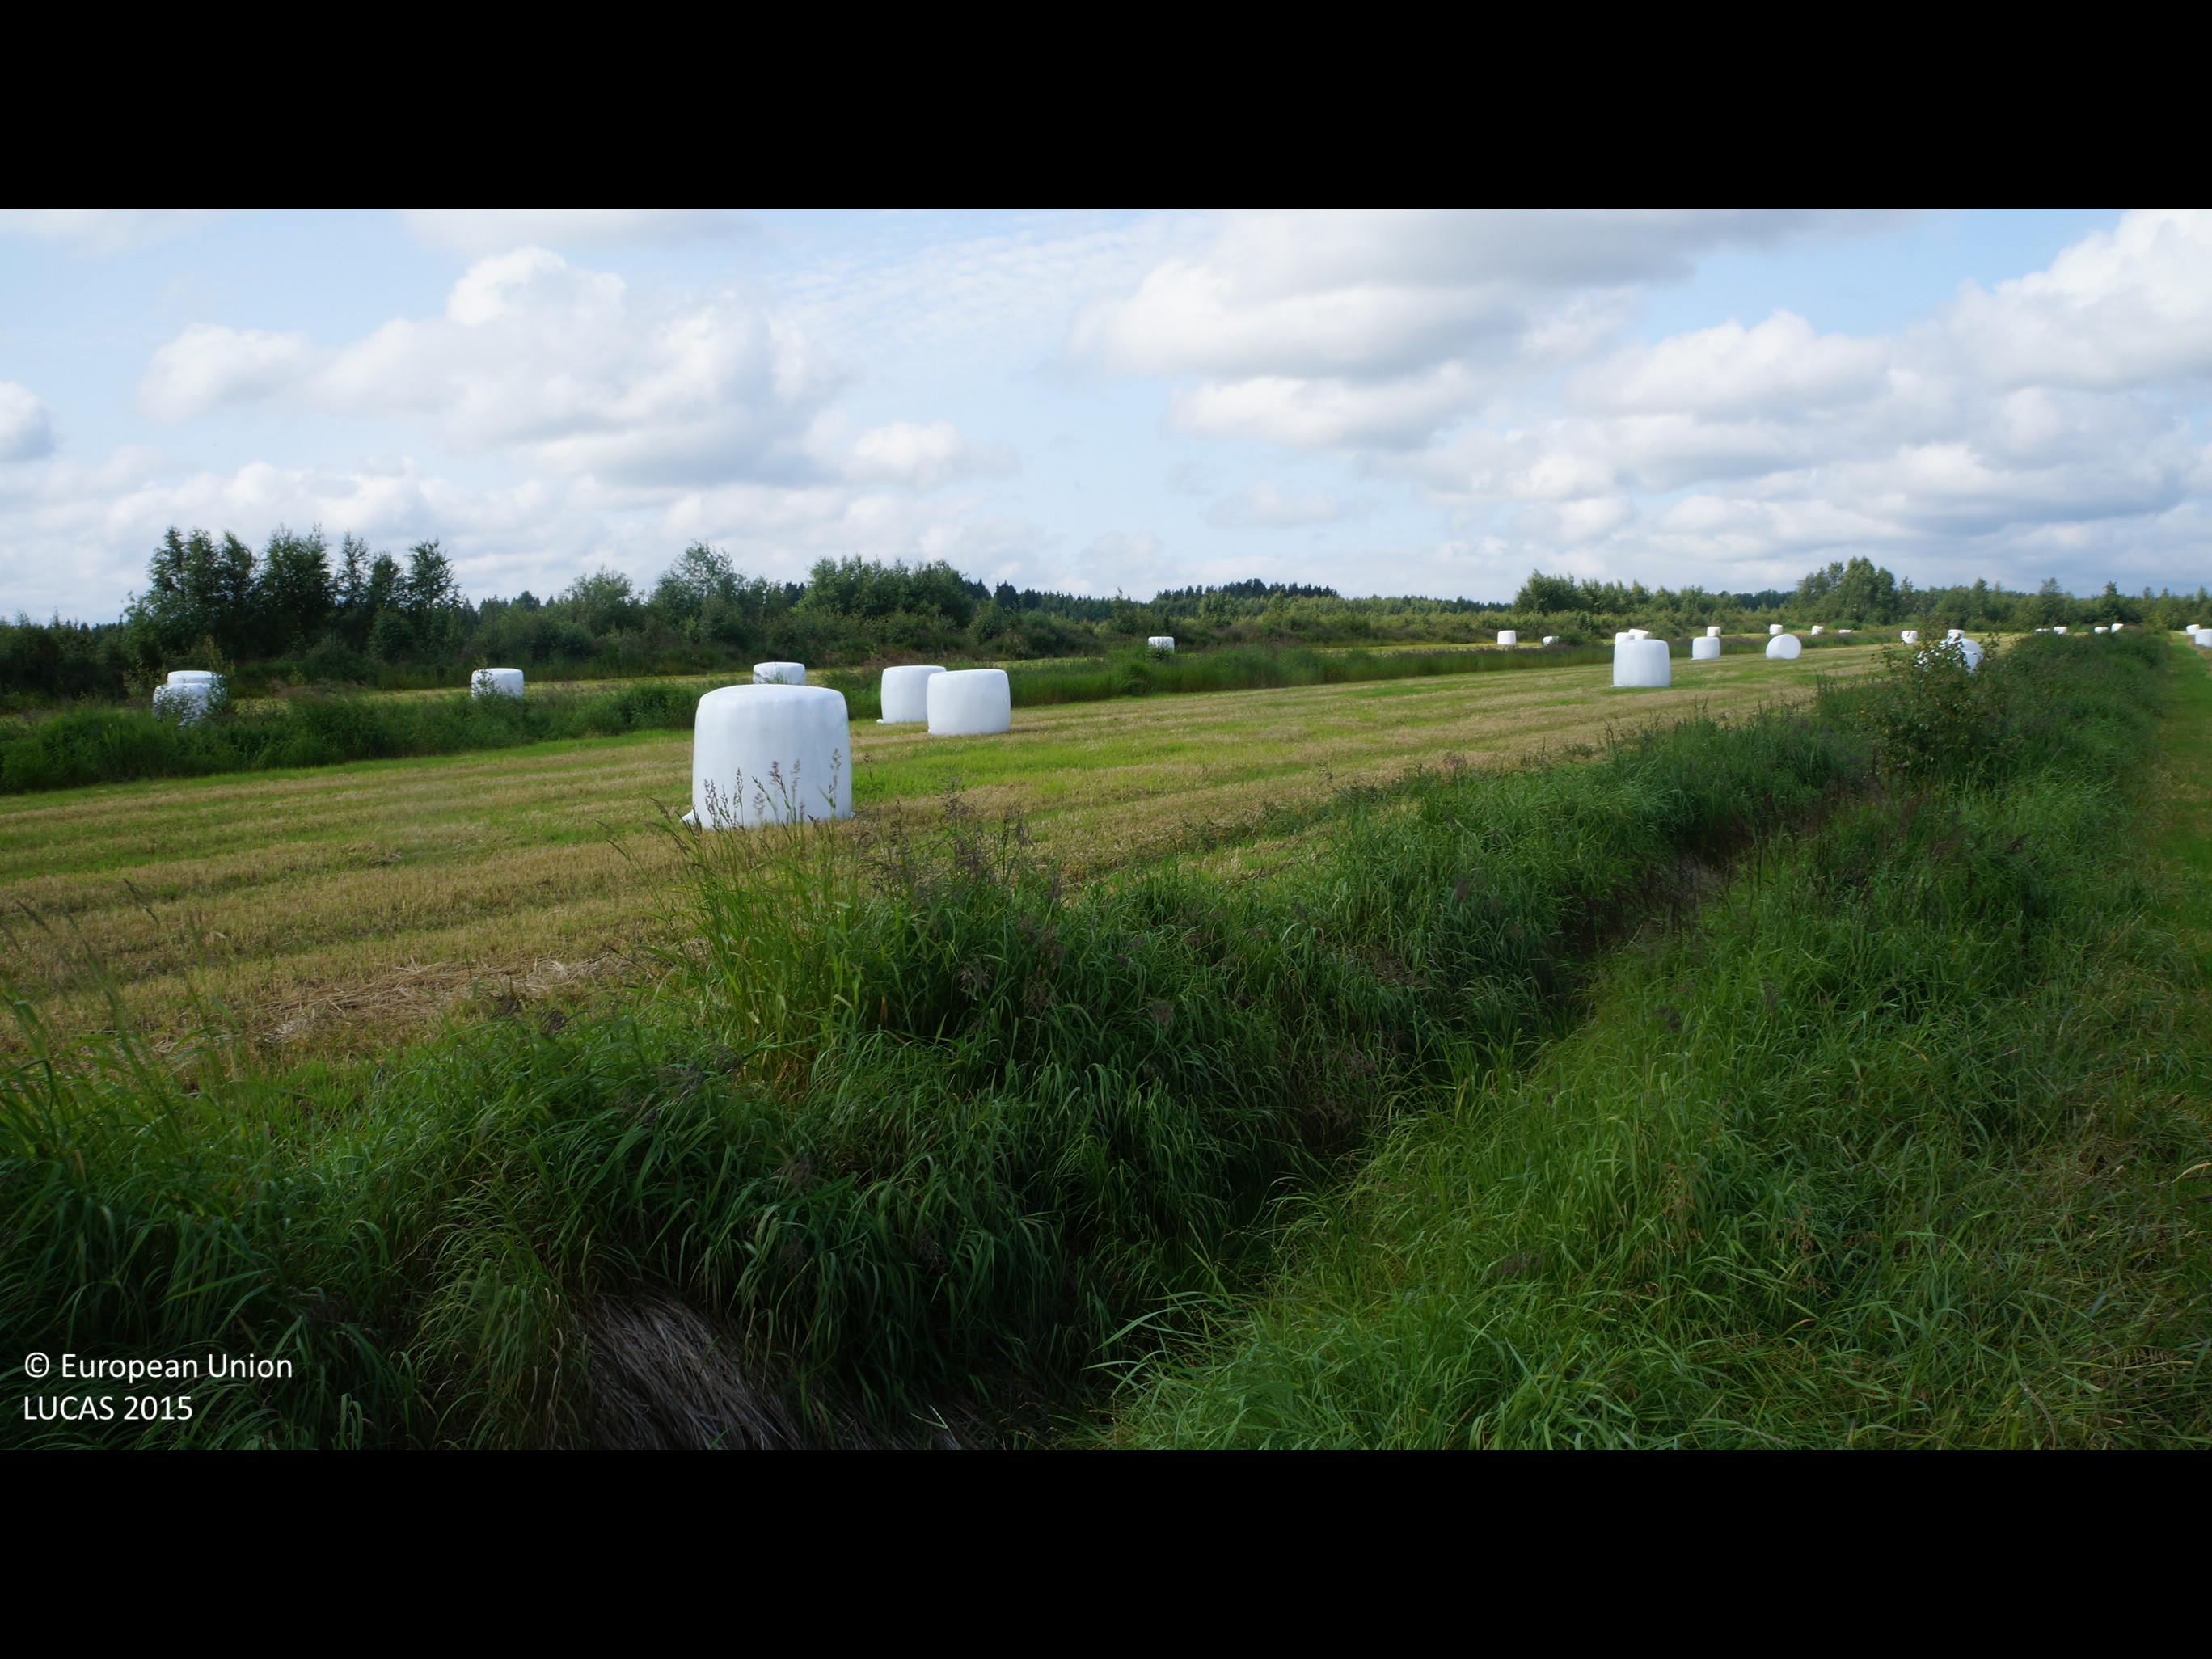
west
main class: Cropland
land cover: Temporary grasslands
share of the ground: > 75 %
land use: Agriculture (excluding fallow land and kitchen gardens)
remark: Harvested field
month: July
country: FI
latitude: 64.1601
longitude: 24.4039
